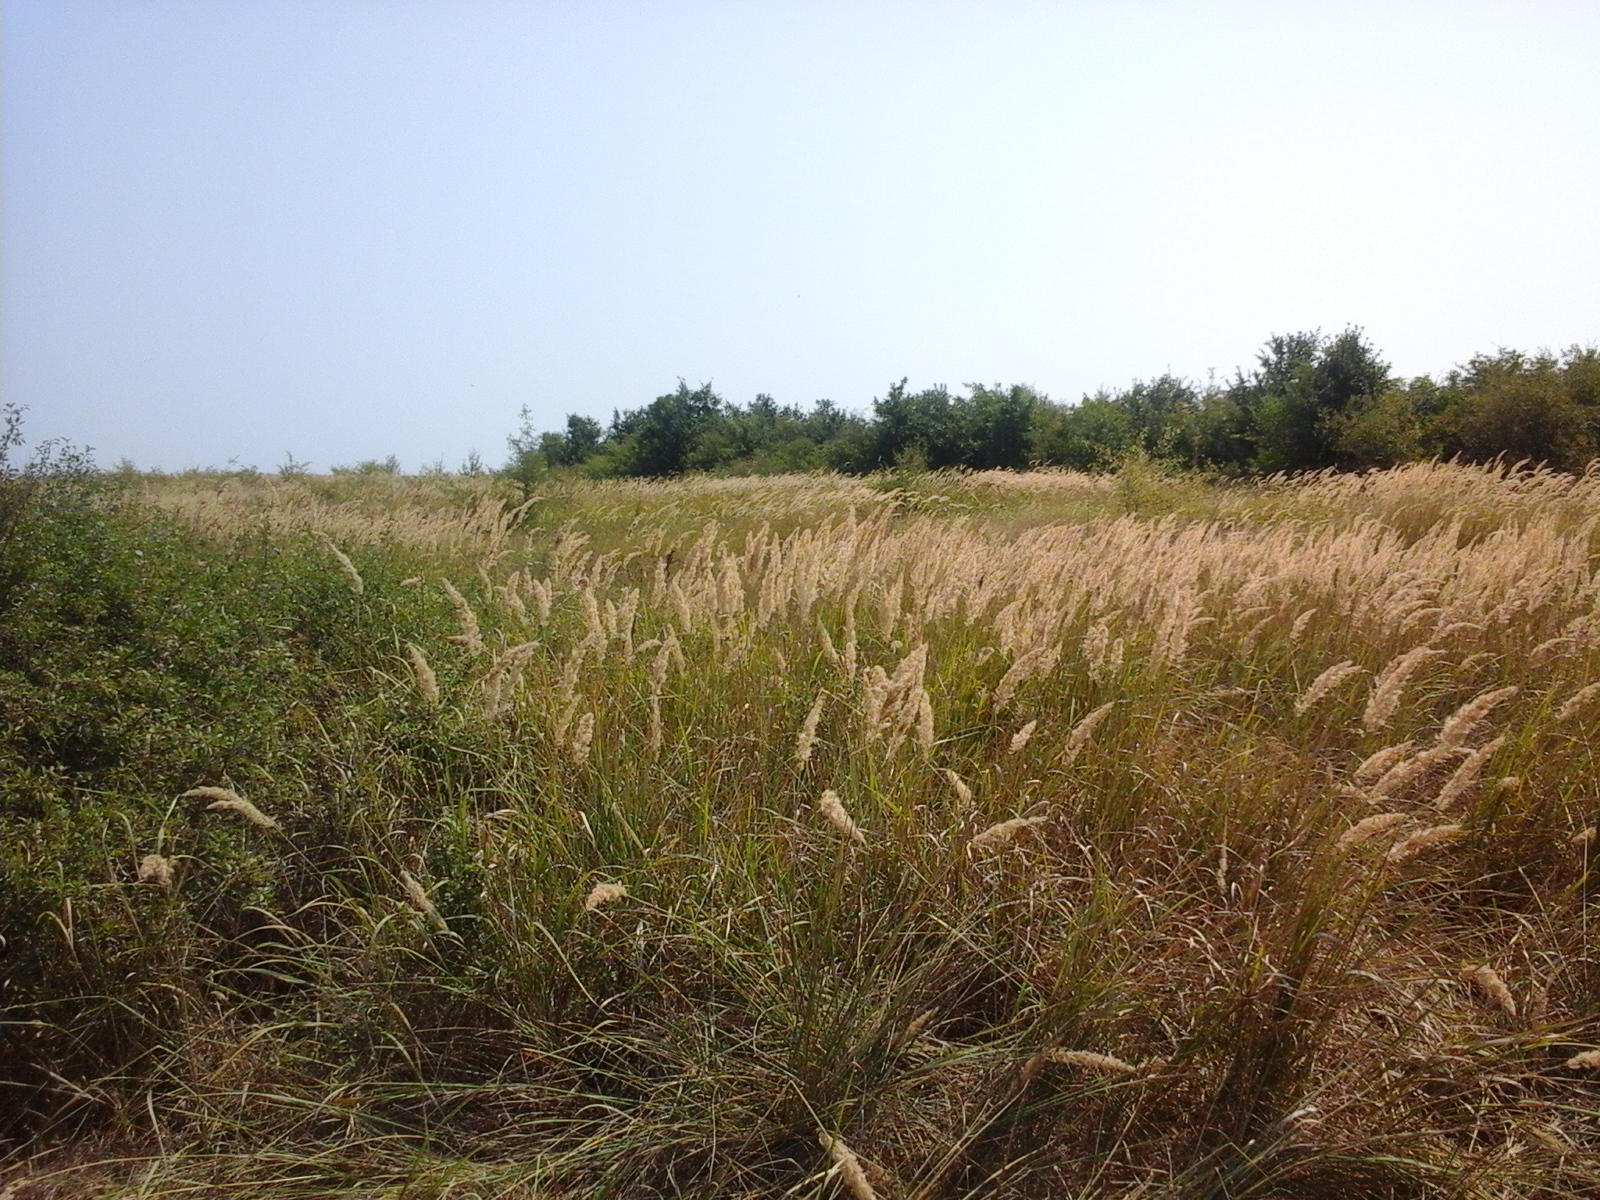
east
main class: Shrubland
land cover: Shrubland with sparse tree cover
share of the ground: > 75 %
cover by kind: shrubs 95 %, broadleaved forest trees 5 %
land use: Semi-natural and natural areas not in use
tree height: < 5 m
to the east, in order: Shrubland with sparse tree cover; Tracks; Shrubland with sparse tree cover; Grassland with sparse tree/shrub cover
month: August
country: RO
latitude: 44.5042
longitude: 23.7805
